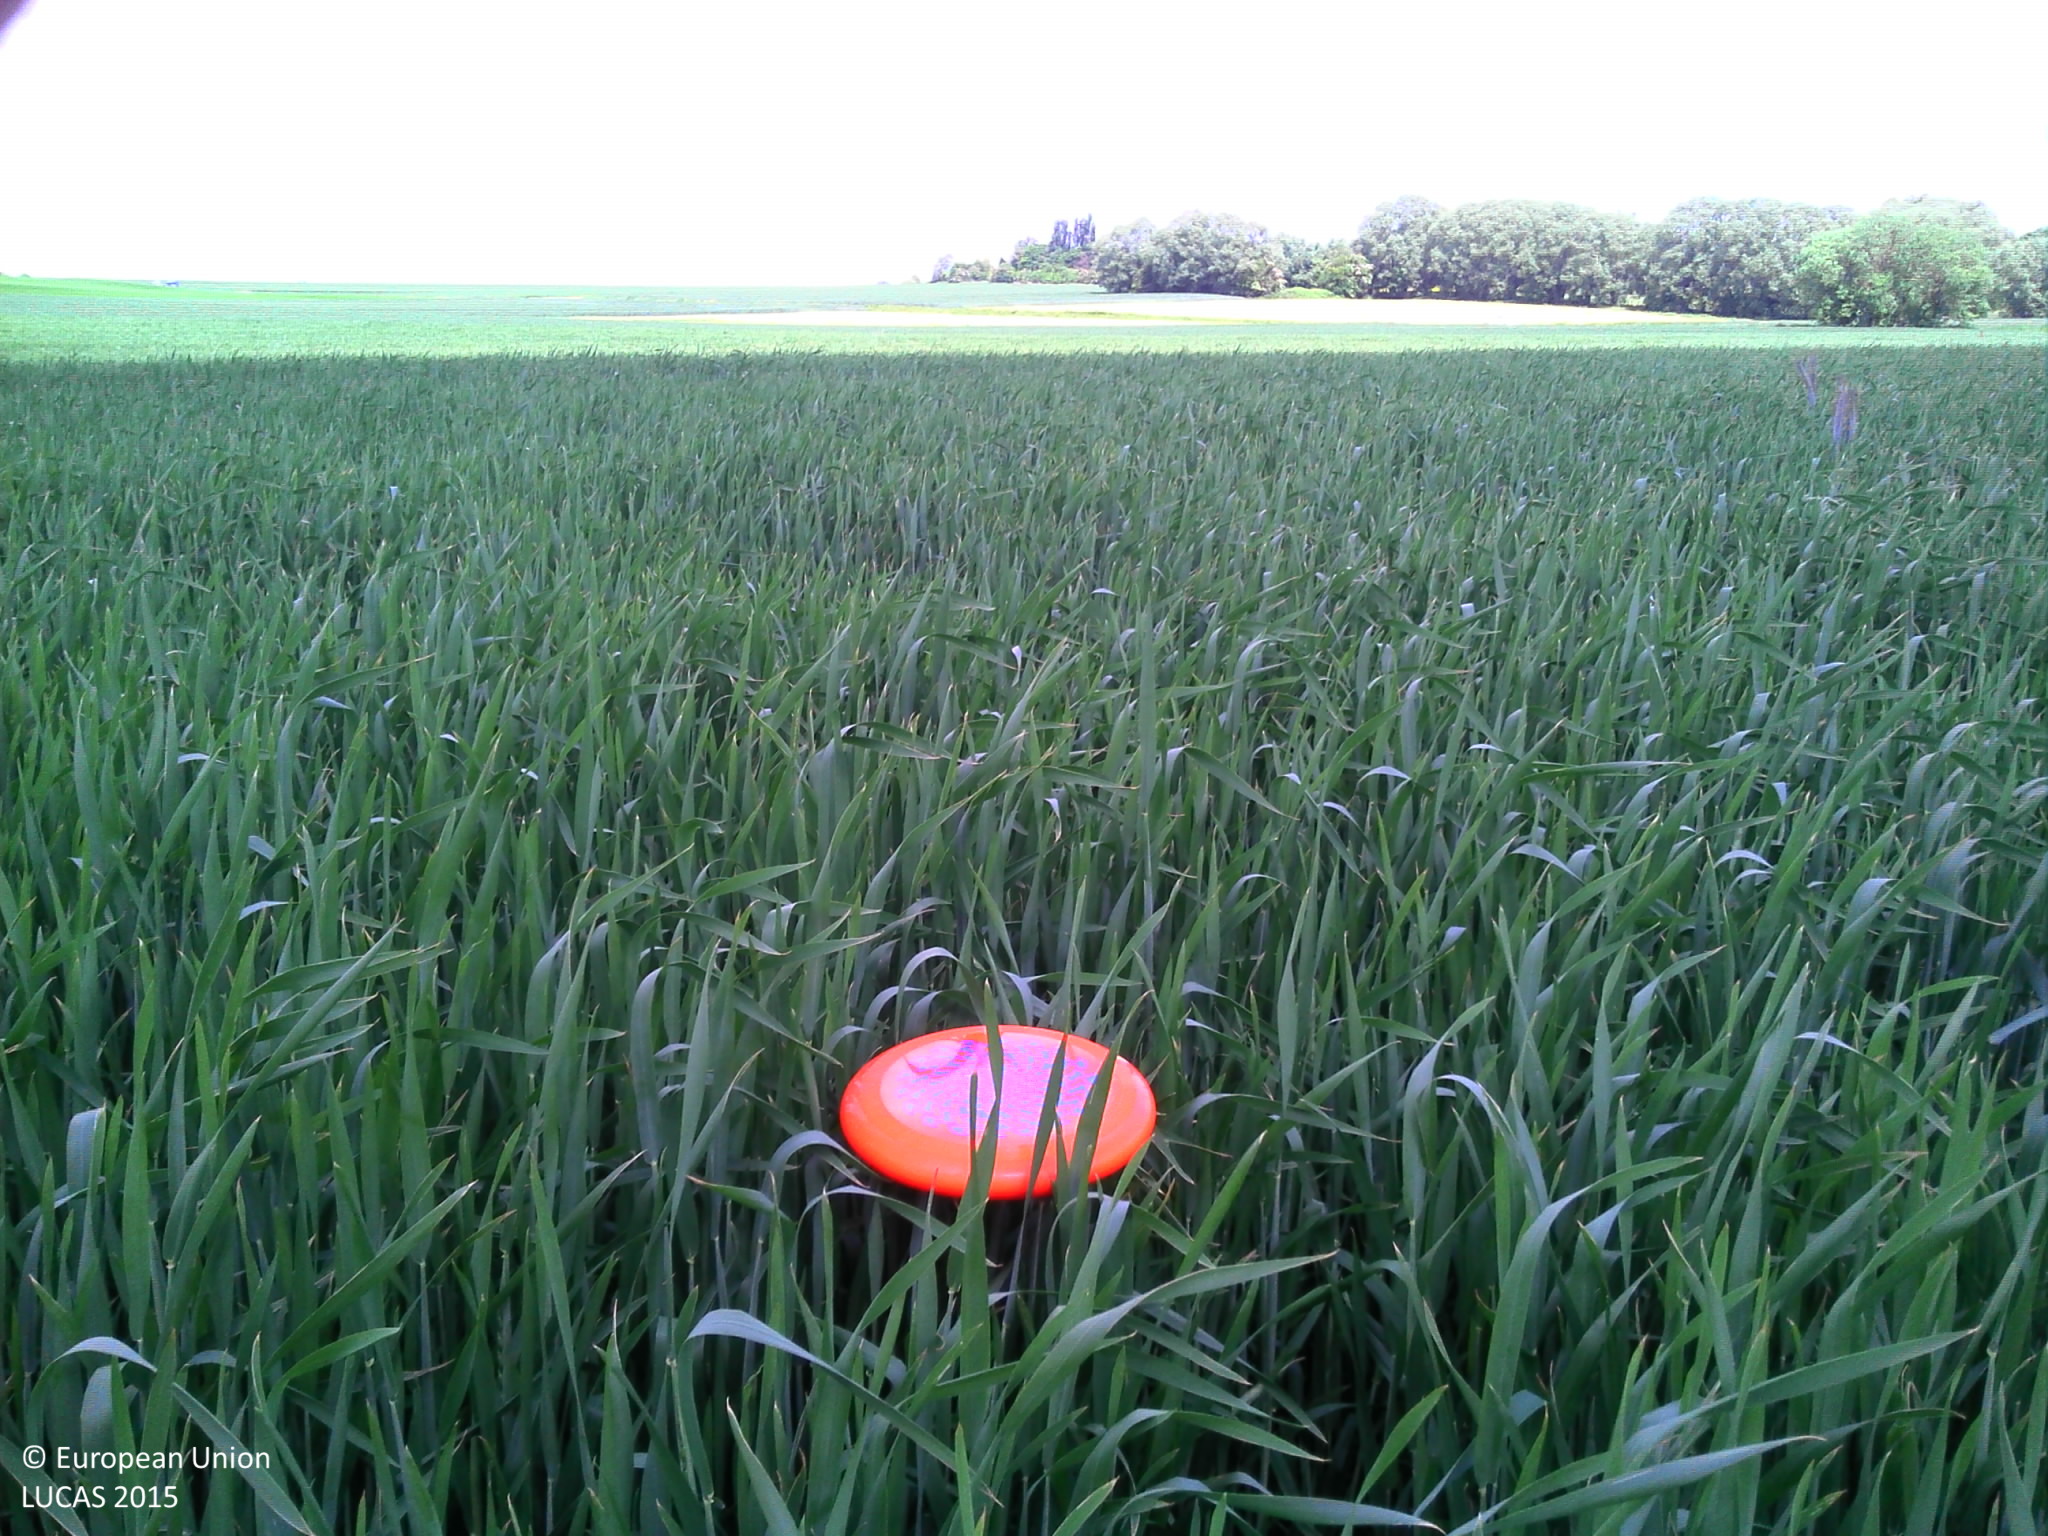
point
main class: Cropland
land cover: Common wheat
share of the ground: > 75 %
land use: Agriculture (excluding fallow land and kitchen gardens)
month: May
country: BE
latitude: 50.6561
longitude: 5.1173
